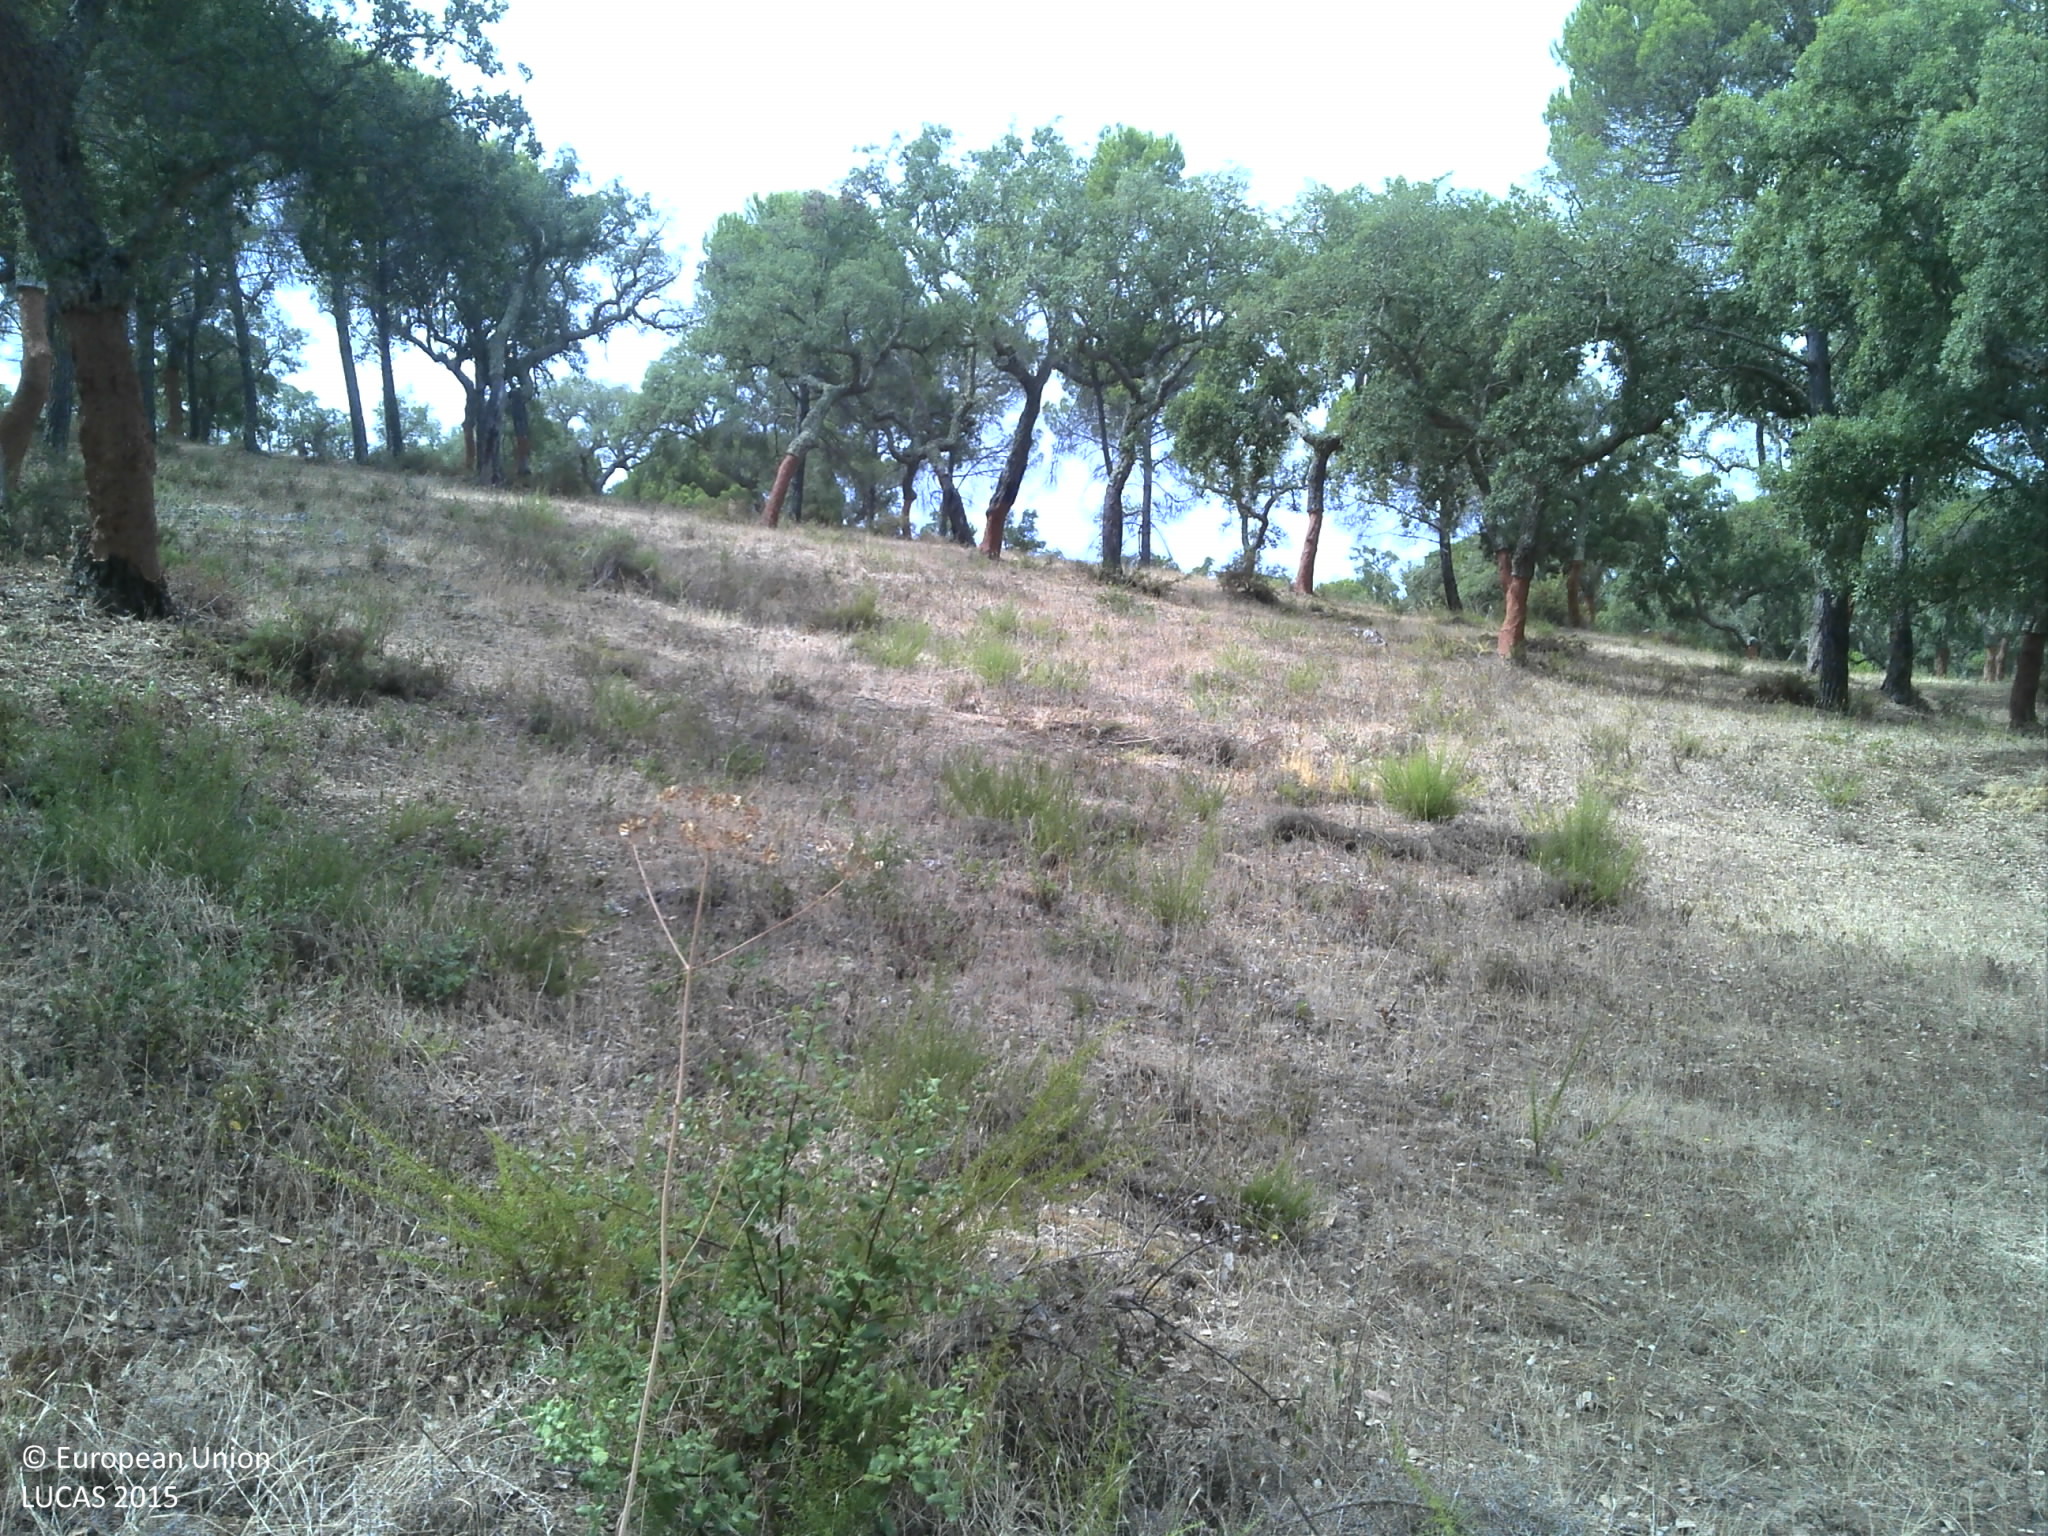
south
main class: Woodland
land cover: Broadleaved woodland
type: broadleaved evergreen forest
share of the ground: 25 - 50 %
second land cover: Grassland without tree/shrub cover
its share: 25 - 50 %
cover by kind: broadleaved forest trees 45 %, unconsolidated bare surface 30 %, herbaceous plants 25 %
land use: Forestry
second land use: Agriculture (excluding fallow land and kitchen gardens)
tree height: > 5 m
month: August
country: PT
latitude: 38.8978
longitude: -8.3080
